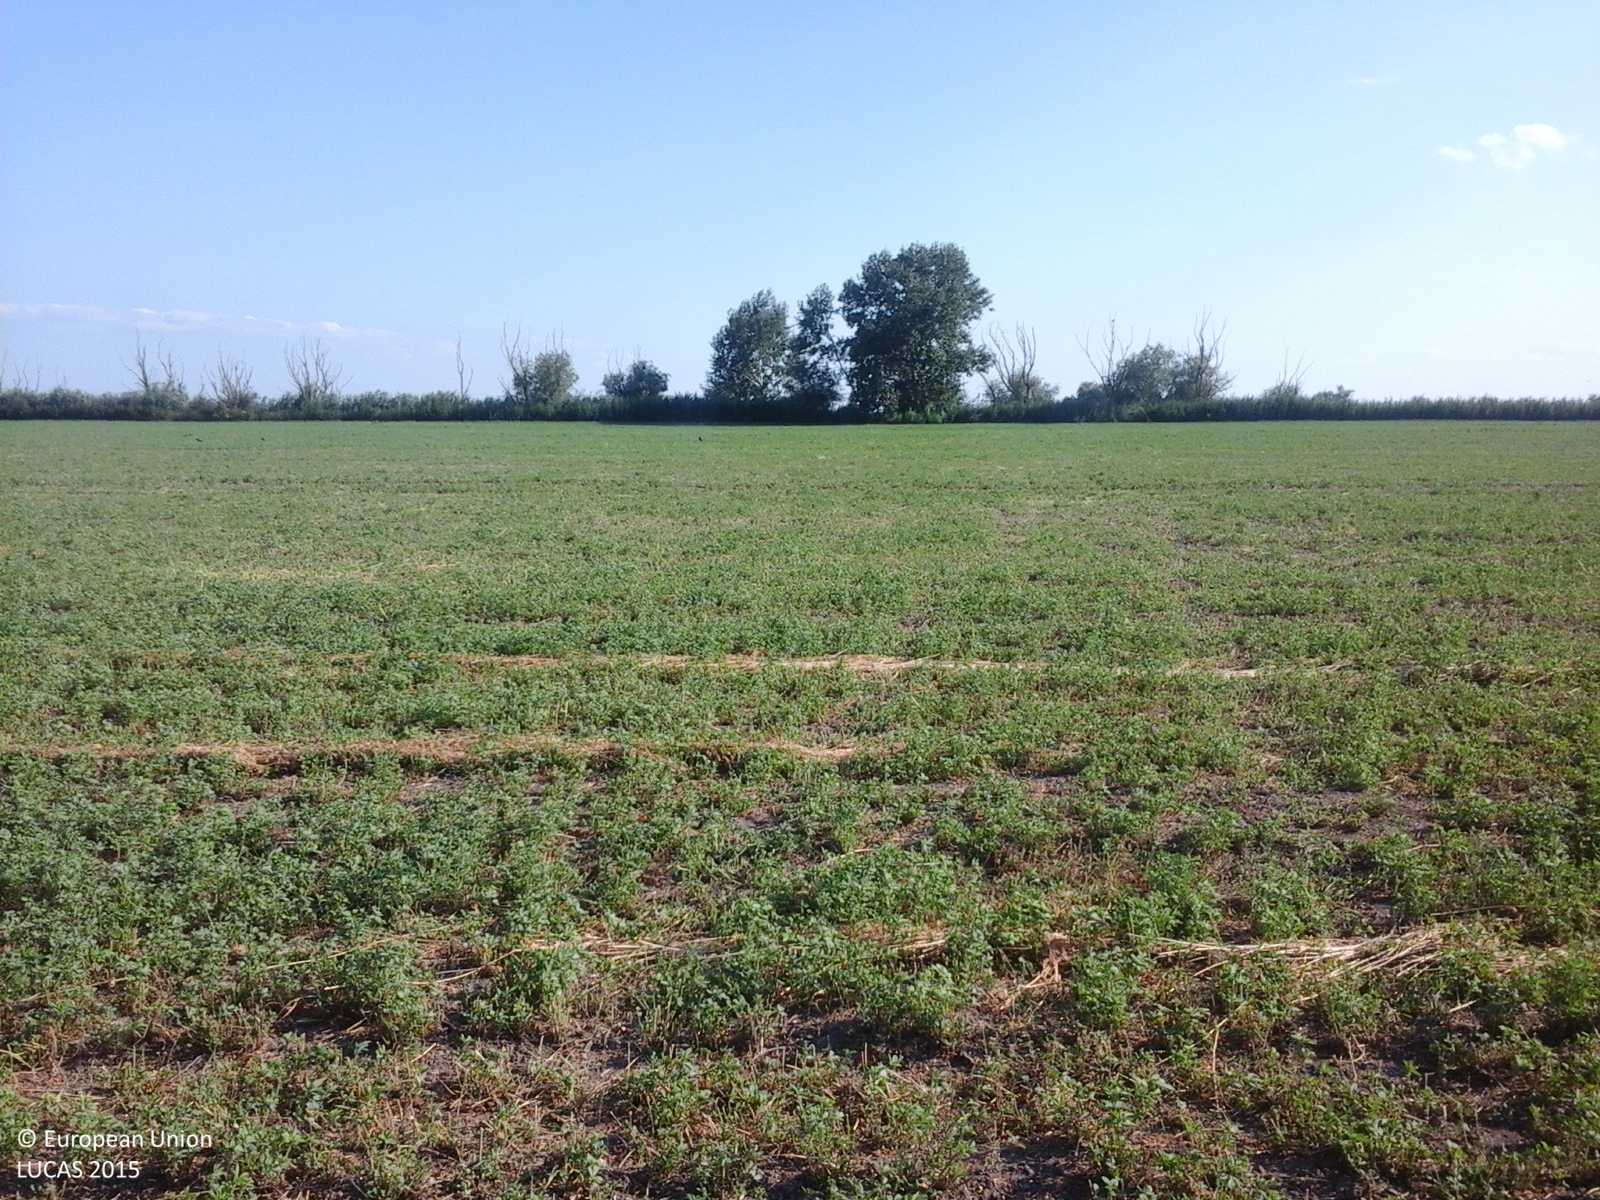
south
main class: Cropland
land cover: Lucerne
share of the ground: > 75 %
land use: Agriculture (excluding fallow land and kitchen gardens)
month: August
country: RO
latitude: 45.3509
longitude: 29.1875
